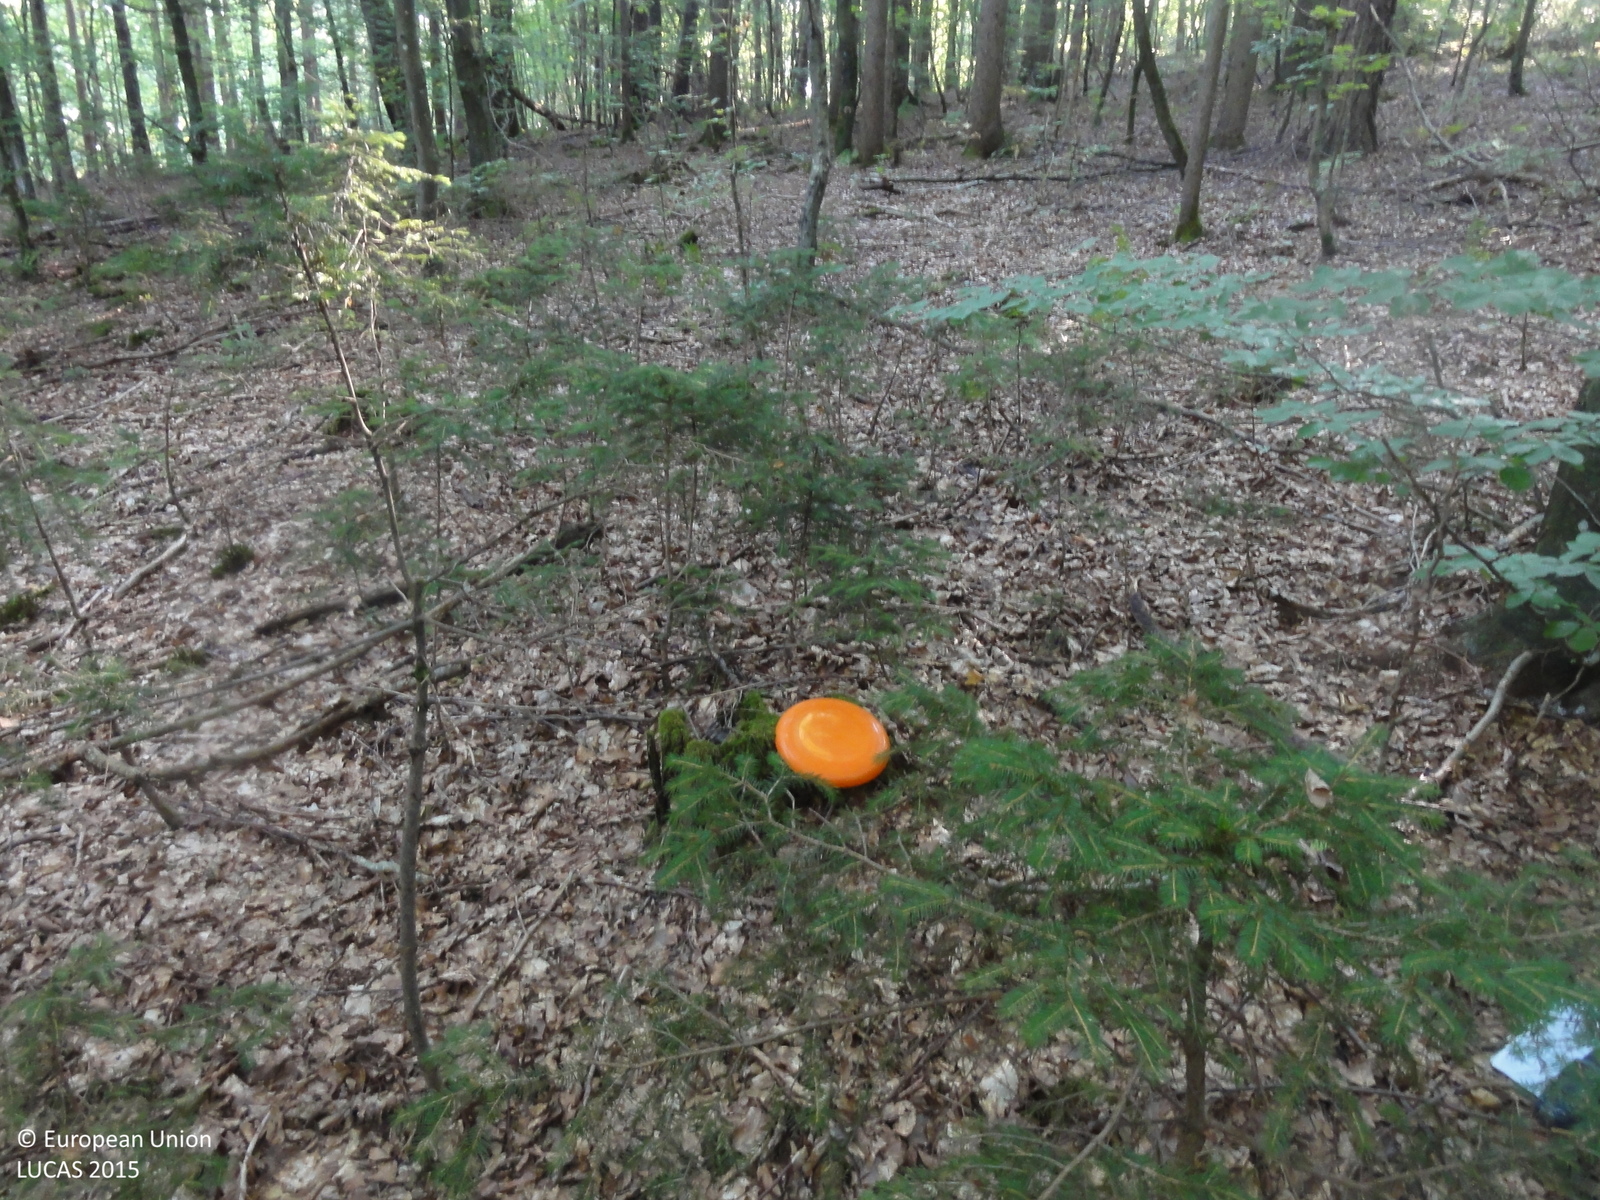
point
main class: Woodland
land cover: Spruce dominated mixed woodland
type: mountainous beech forest
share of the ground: > 75 %
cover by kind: broadleaved forest trees 60 %, coniferous forest trees 40 %
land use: Forestry
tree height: > 5 m
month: August
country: SI
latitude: 45.9269
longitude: 15.0130
